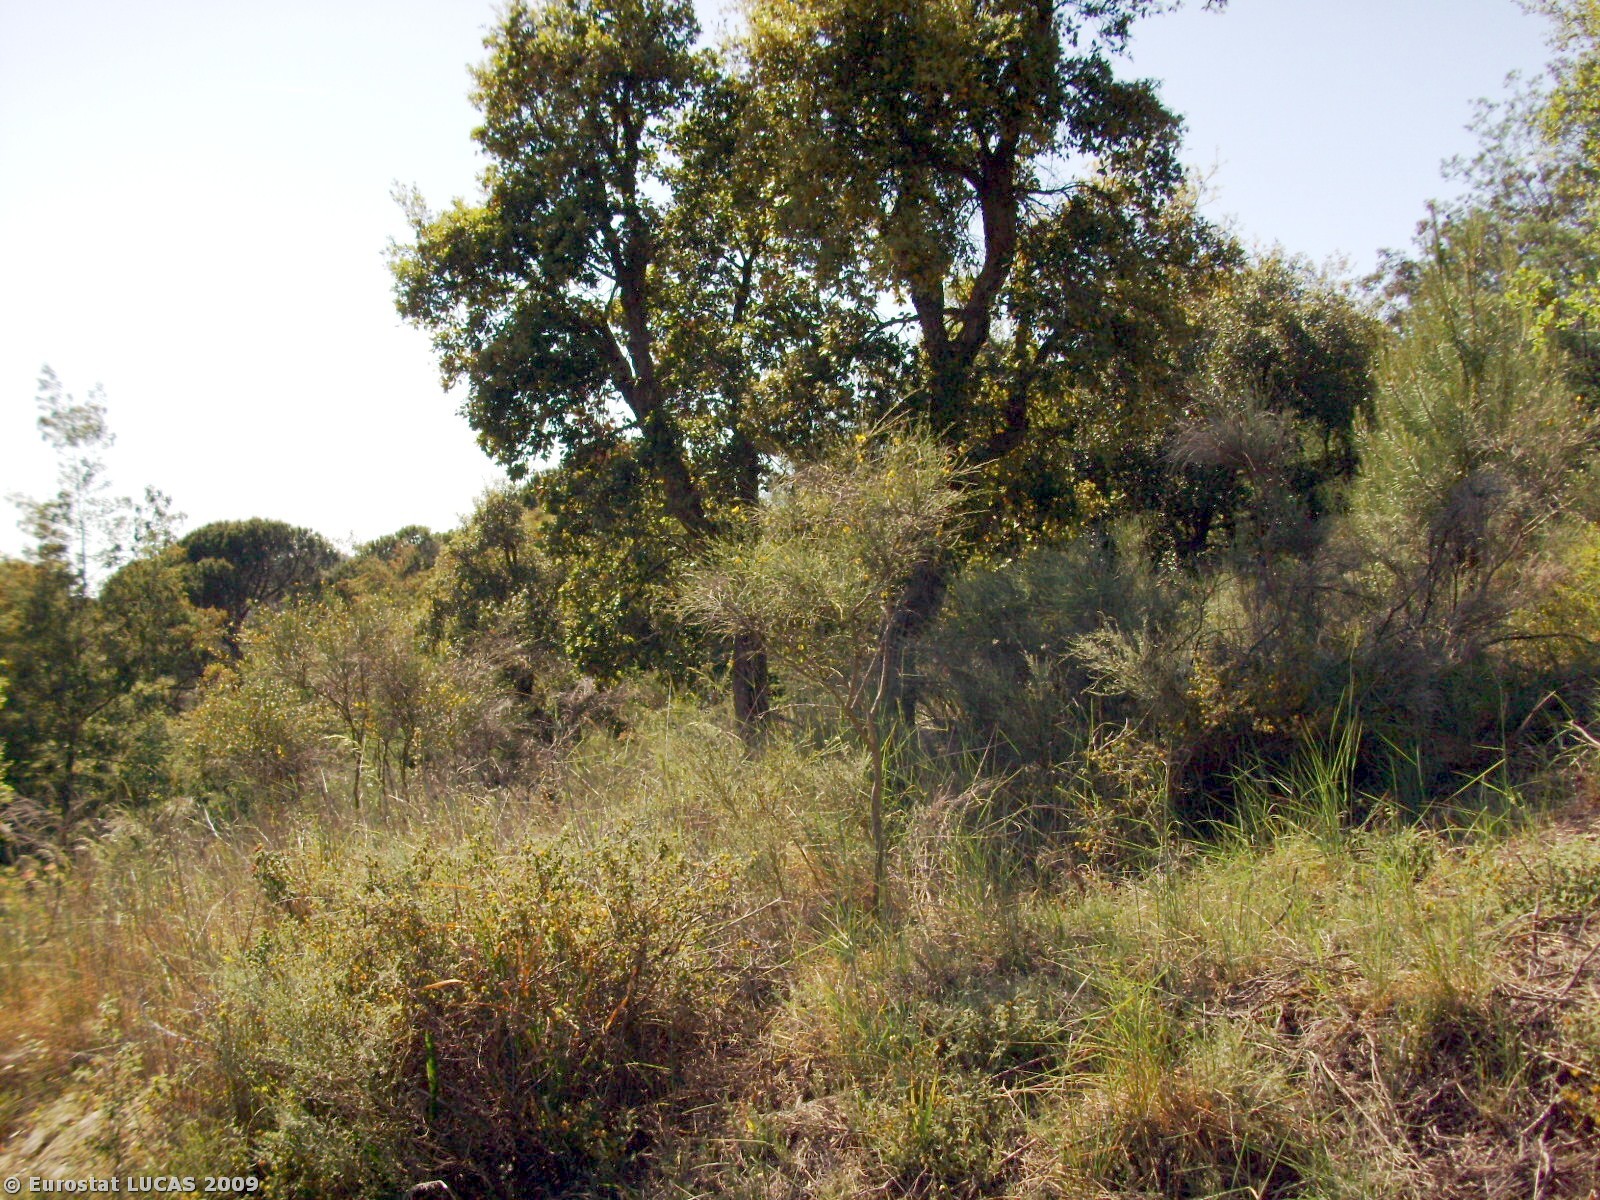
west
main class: Grassland
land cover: Grassland with sparse tree/shrub cover
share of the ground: 50 - 75 %
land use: Forestry
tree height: > 5 m
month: May
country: PT
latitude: 39.3036
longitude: -7.4245
